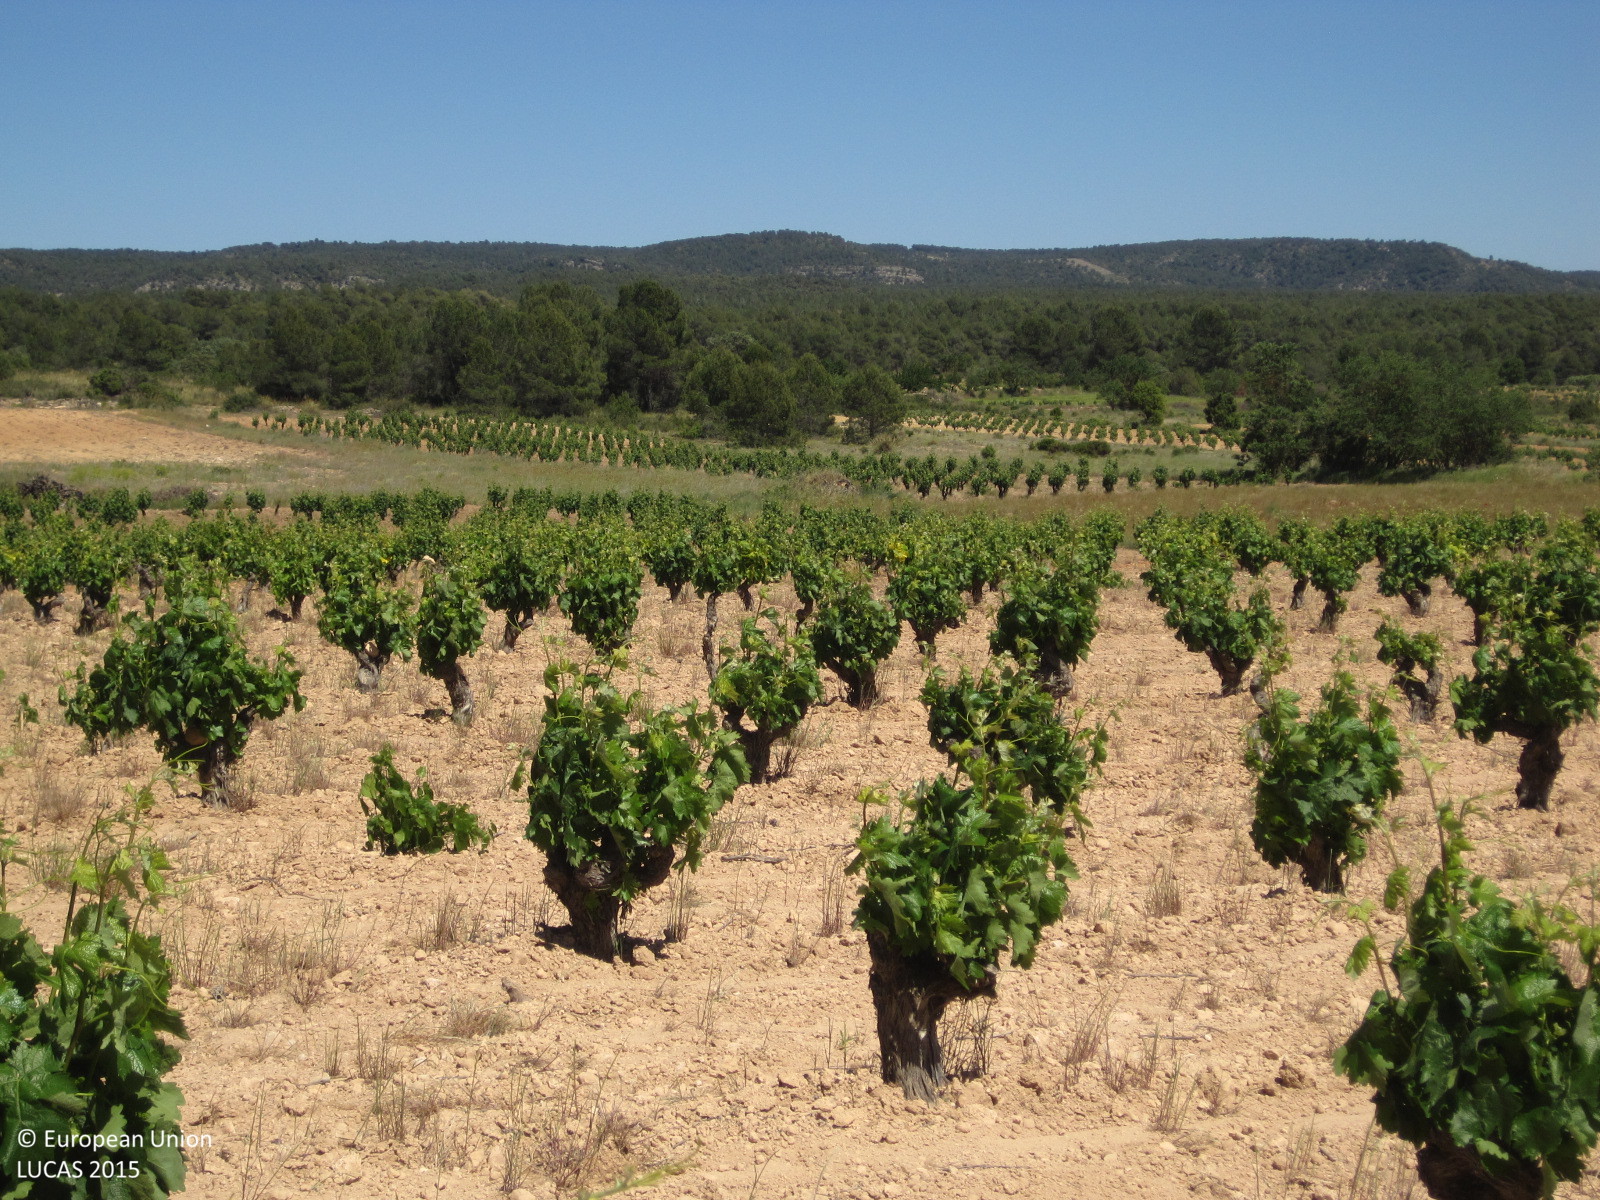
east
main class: Cropland
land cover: Vineyards
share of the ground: 10 - 25 %
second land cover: Spontaneously vegetated surfaces
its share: < 10 %
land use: Agriculture (excluding fallow land and kitchen gardens)
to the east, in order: Vineyards; Spontaneously vegetated surfaces; Grass margins; Vineyards
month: May
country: ES
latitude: 39.4172
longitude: -1.0929
